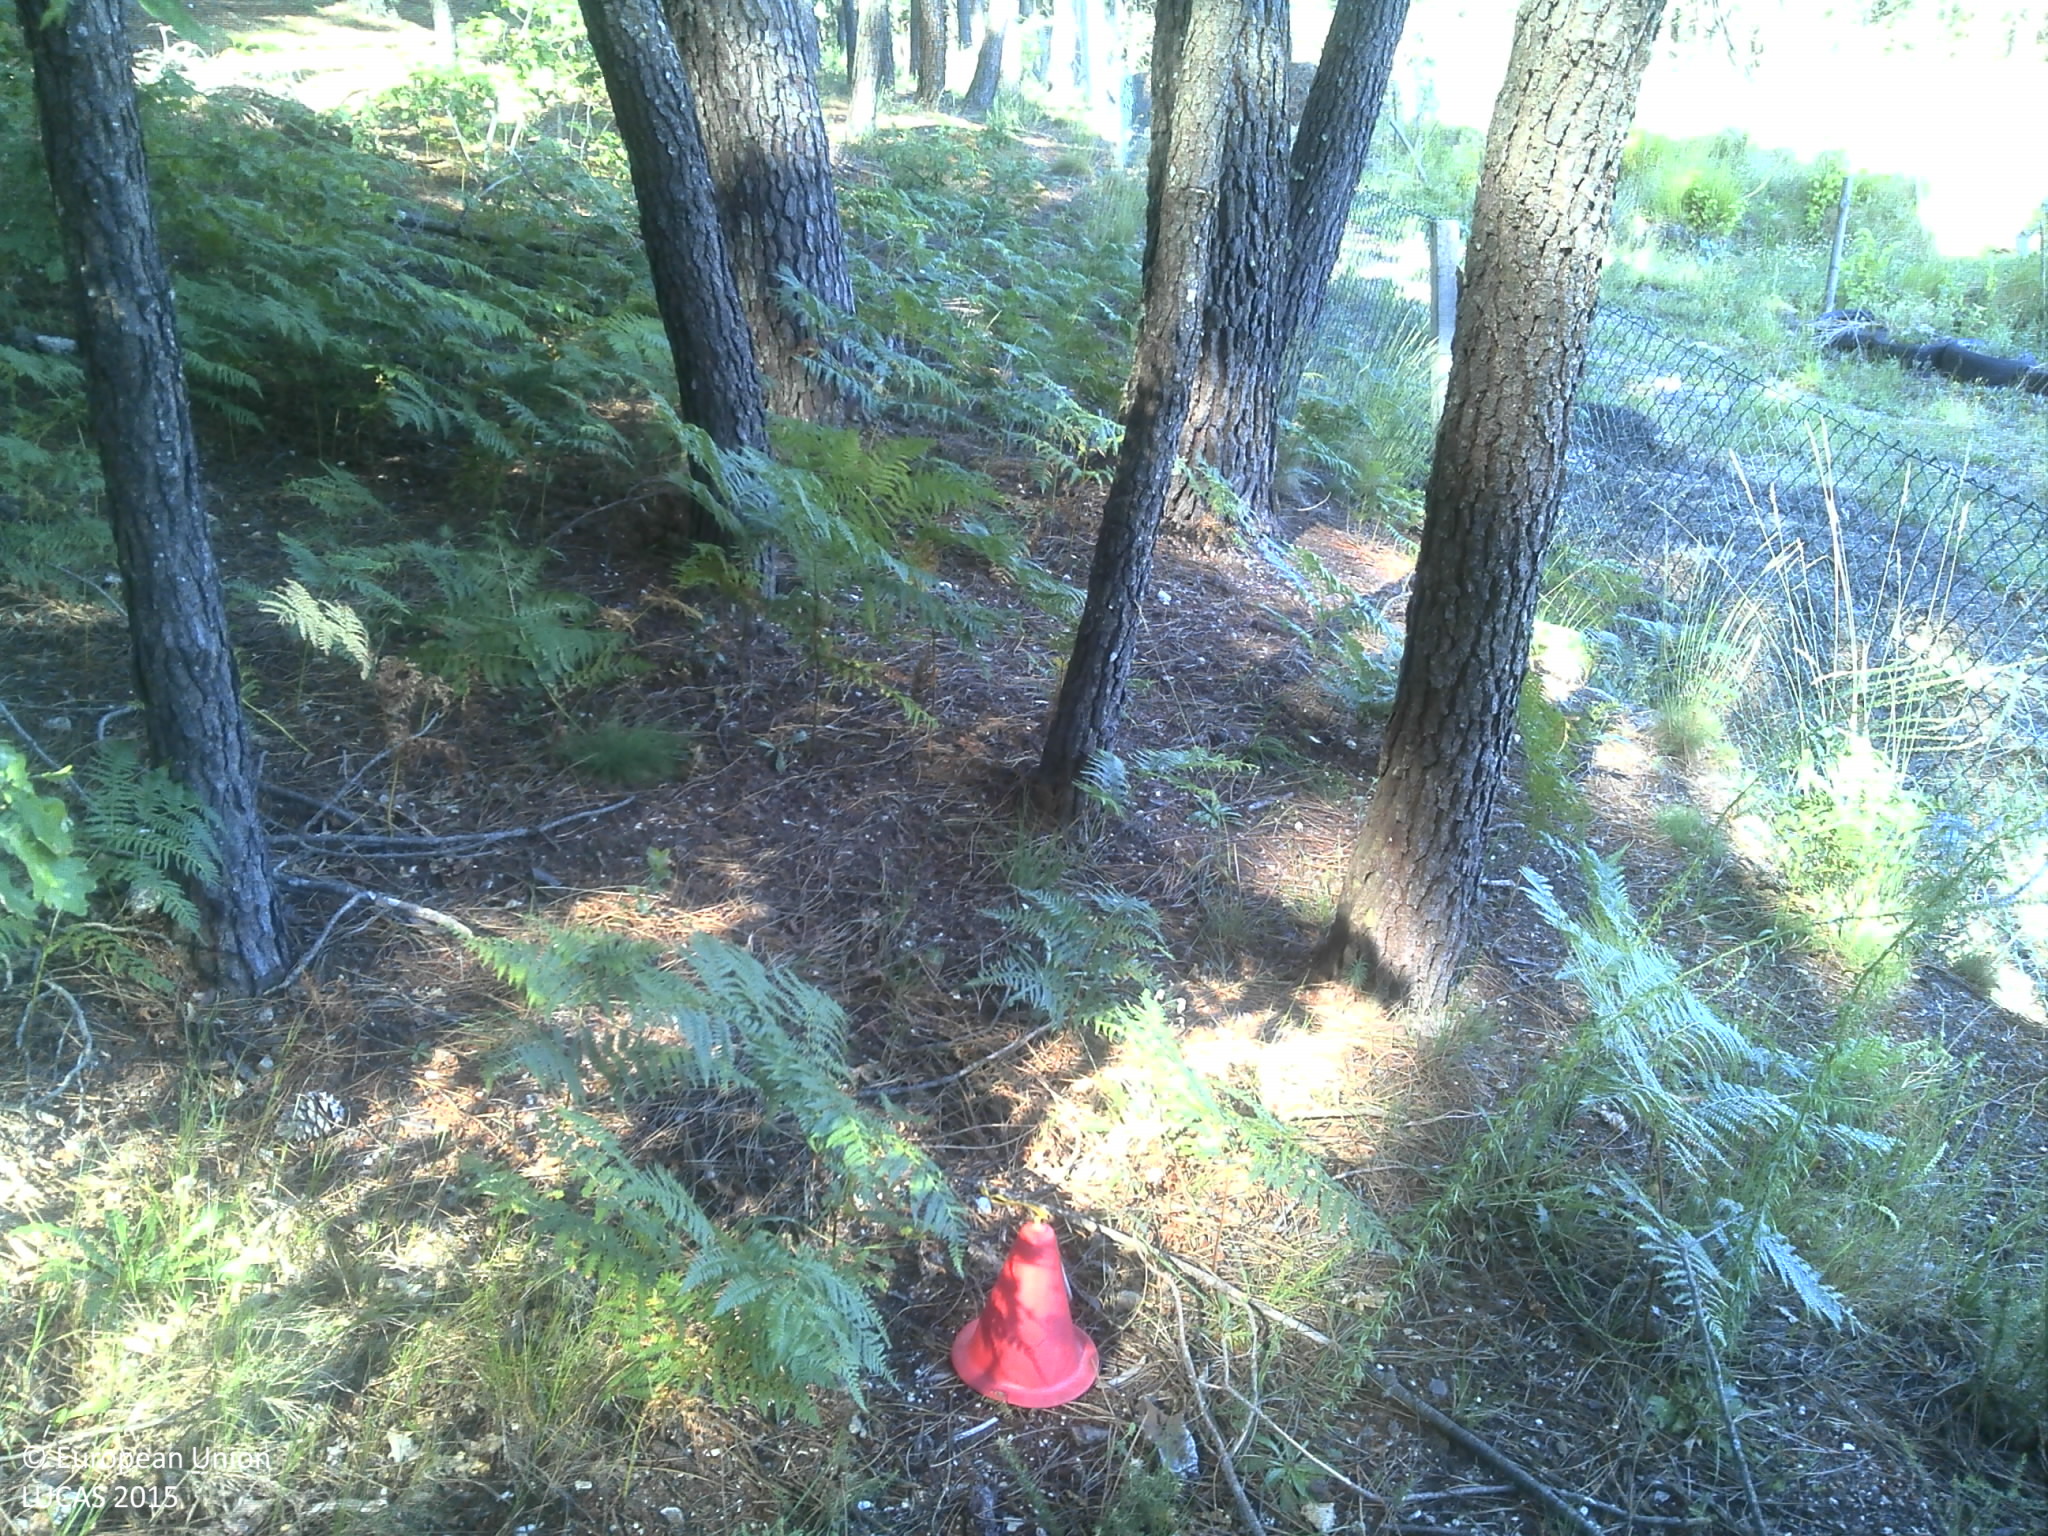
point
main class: Woodland
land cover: Pine dominated coniferous woodland
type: coniferous forest of the mediterranean region
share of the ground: 50 - 75 %
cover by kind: coniferous forest trees 70 %, shrubs 15 %, unconsolidated bare surface 10 %, herbaceous plants 5 %
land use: Forestry
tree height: > 5 m
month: June
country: PT
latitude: 41.3698
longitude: -8.1356
